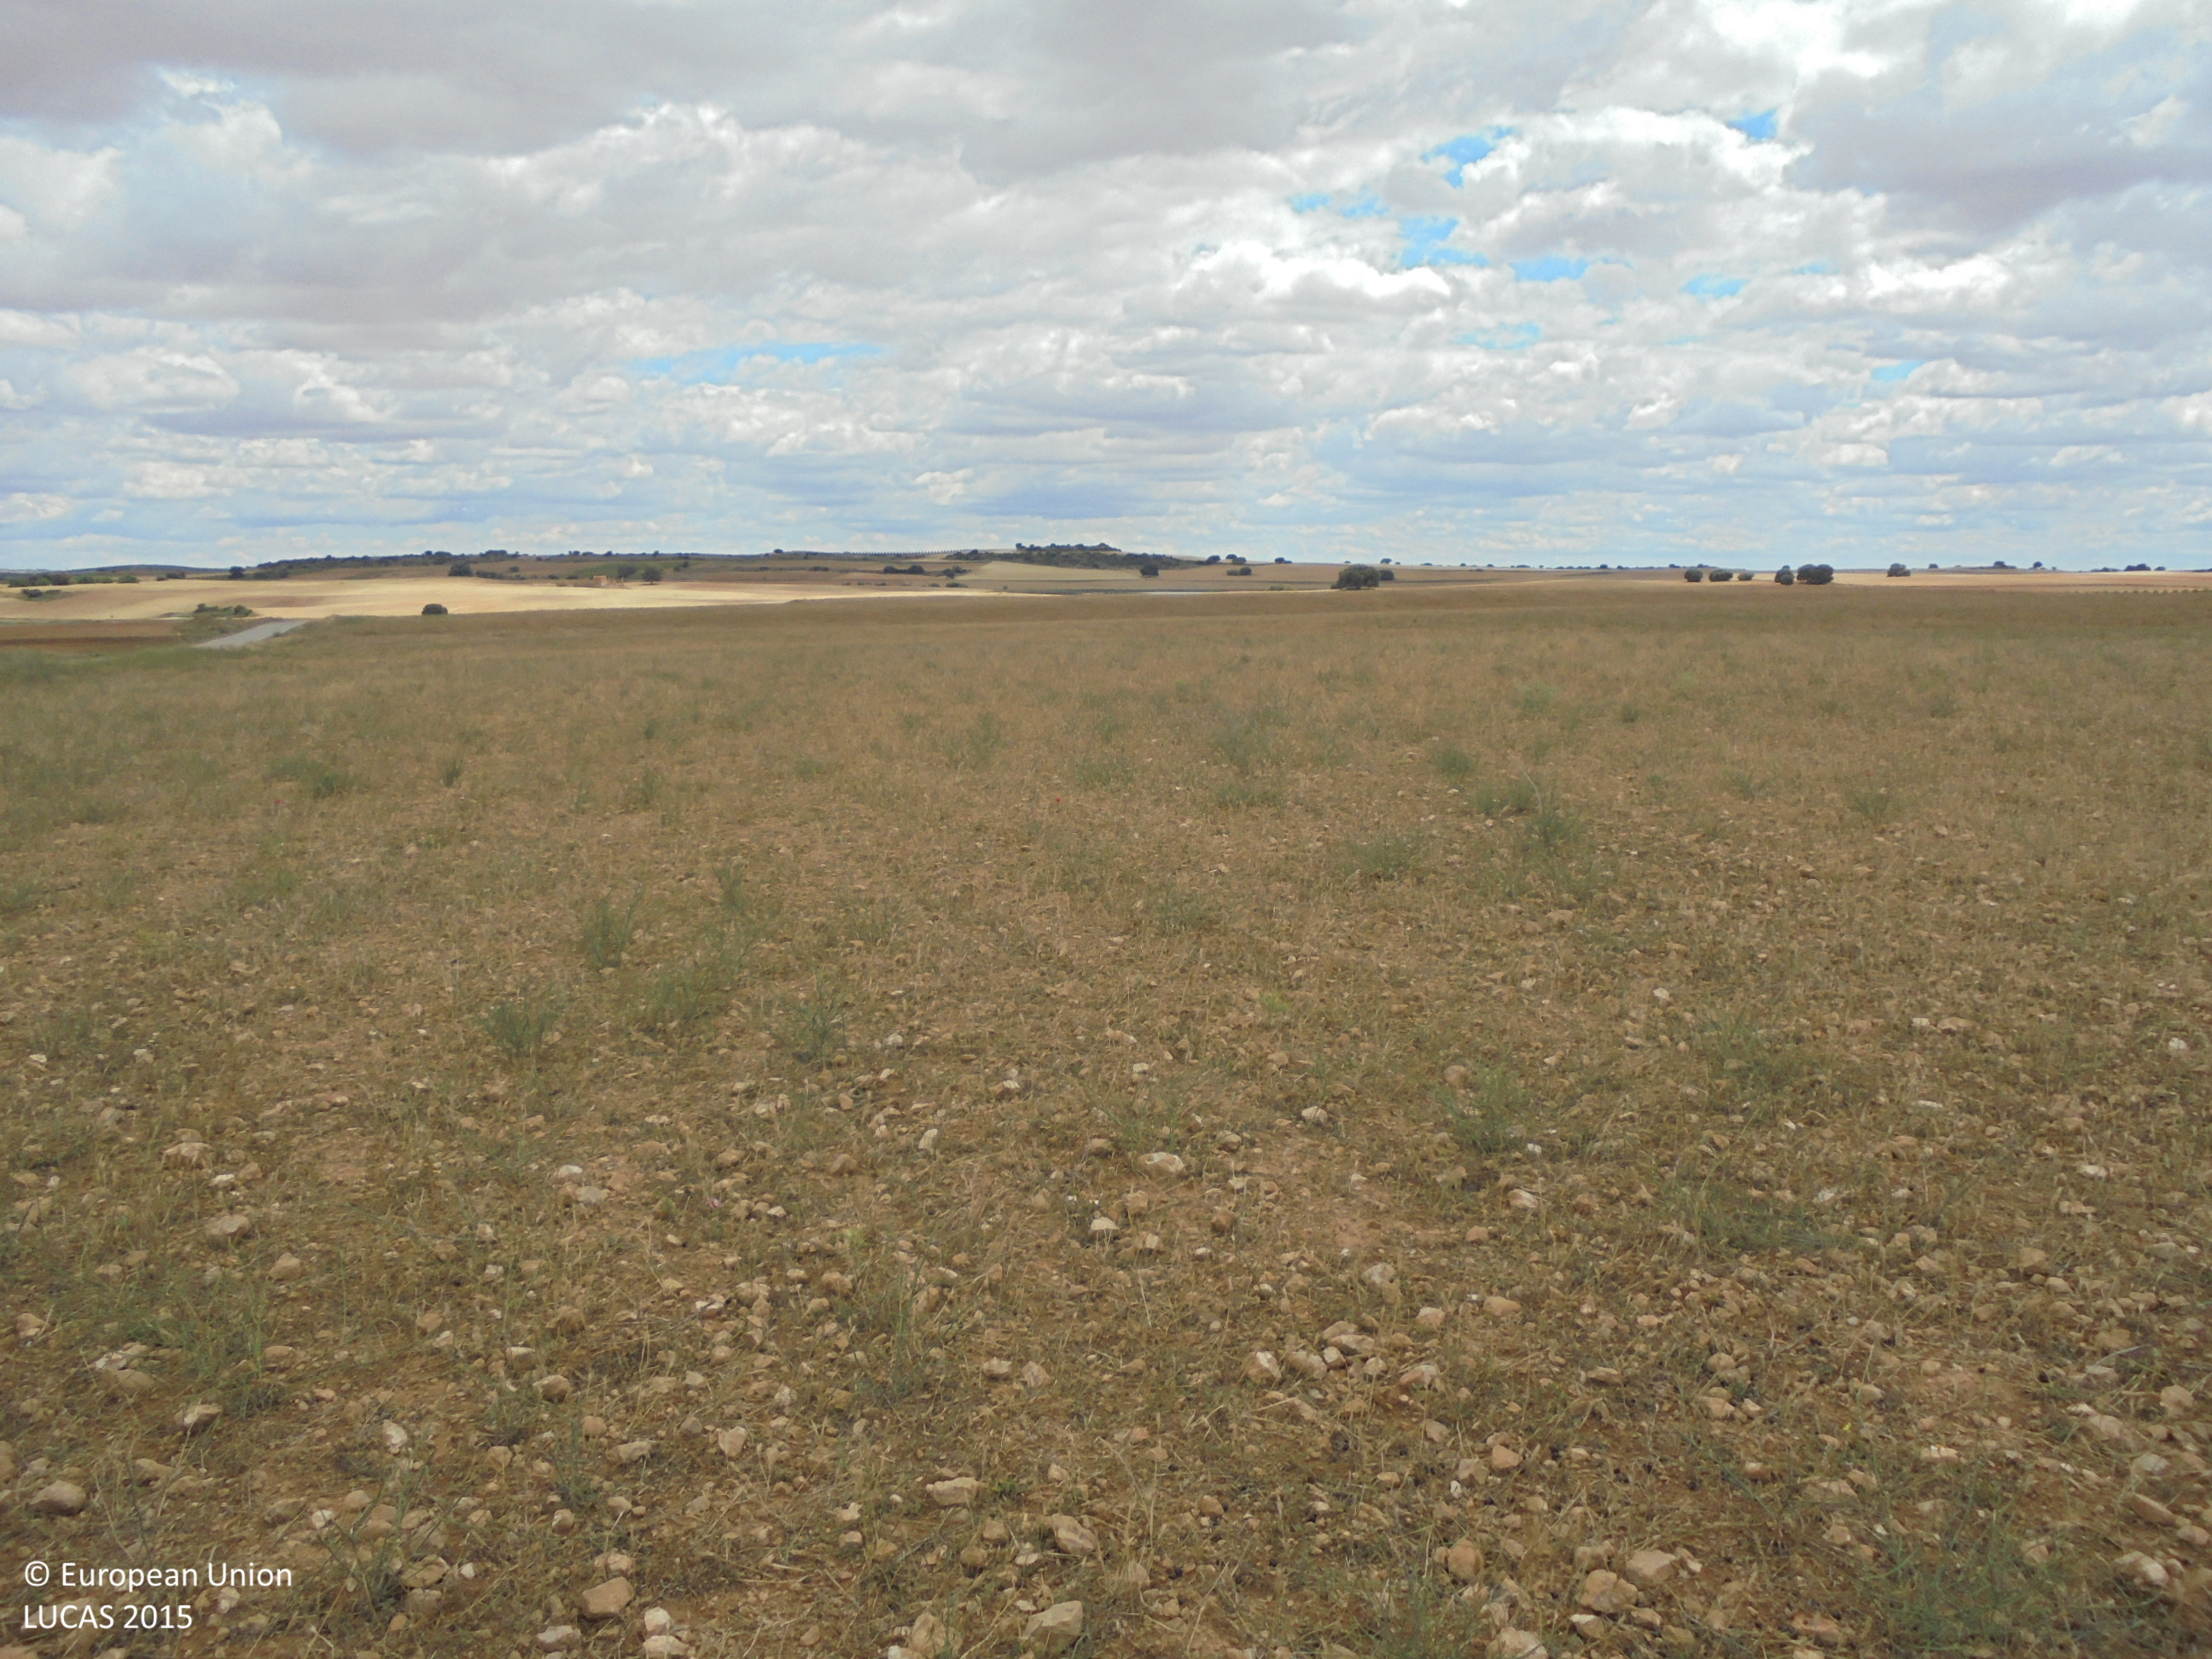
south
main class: Grassland
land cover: Spontaneously vegetated surfaces
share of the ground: 25 - 50 %
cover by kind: unconsolidated bare surface 55 %, herbaceous plants 45 %
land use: Agriculture (excluding fallow land and kitchen gardens)
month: June
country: ES
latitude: 38.7936
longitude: -1.4279
